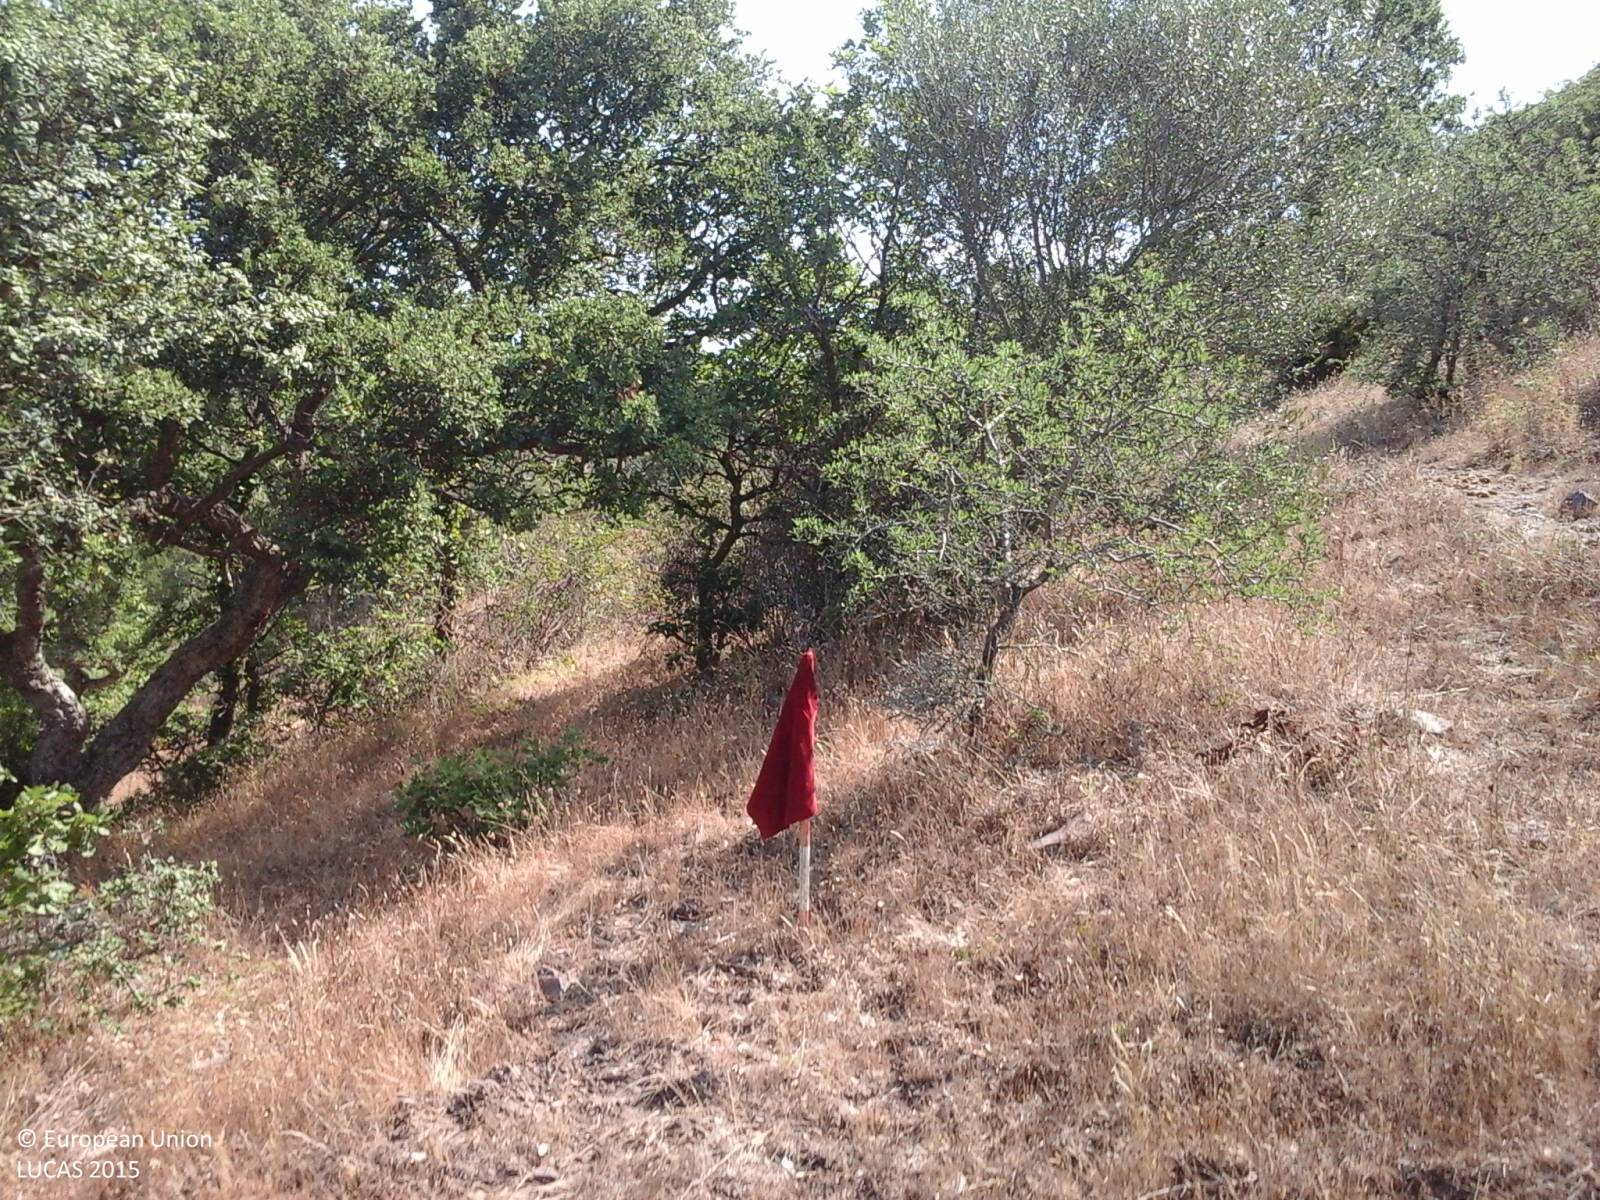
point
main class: Woodland
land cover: Broadleaved woodland
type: broadleaved evergreen forest
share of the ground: 10 - 25 %
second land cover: Grassland without tree/shrub cover
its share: 25 - 50 %
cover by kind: herbaceous plants 65 %, broadleaved forest trees 25 %, shrubs 10 %
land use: Forestry
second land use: Agriculture (excluding fallow land and kitchen gardens)
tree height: > 5 m
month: July
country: IT
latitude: 40.5272
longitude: 8.4848
